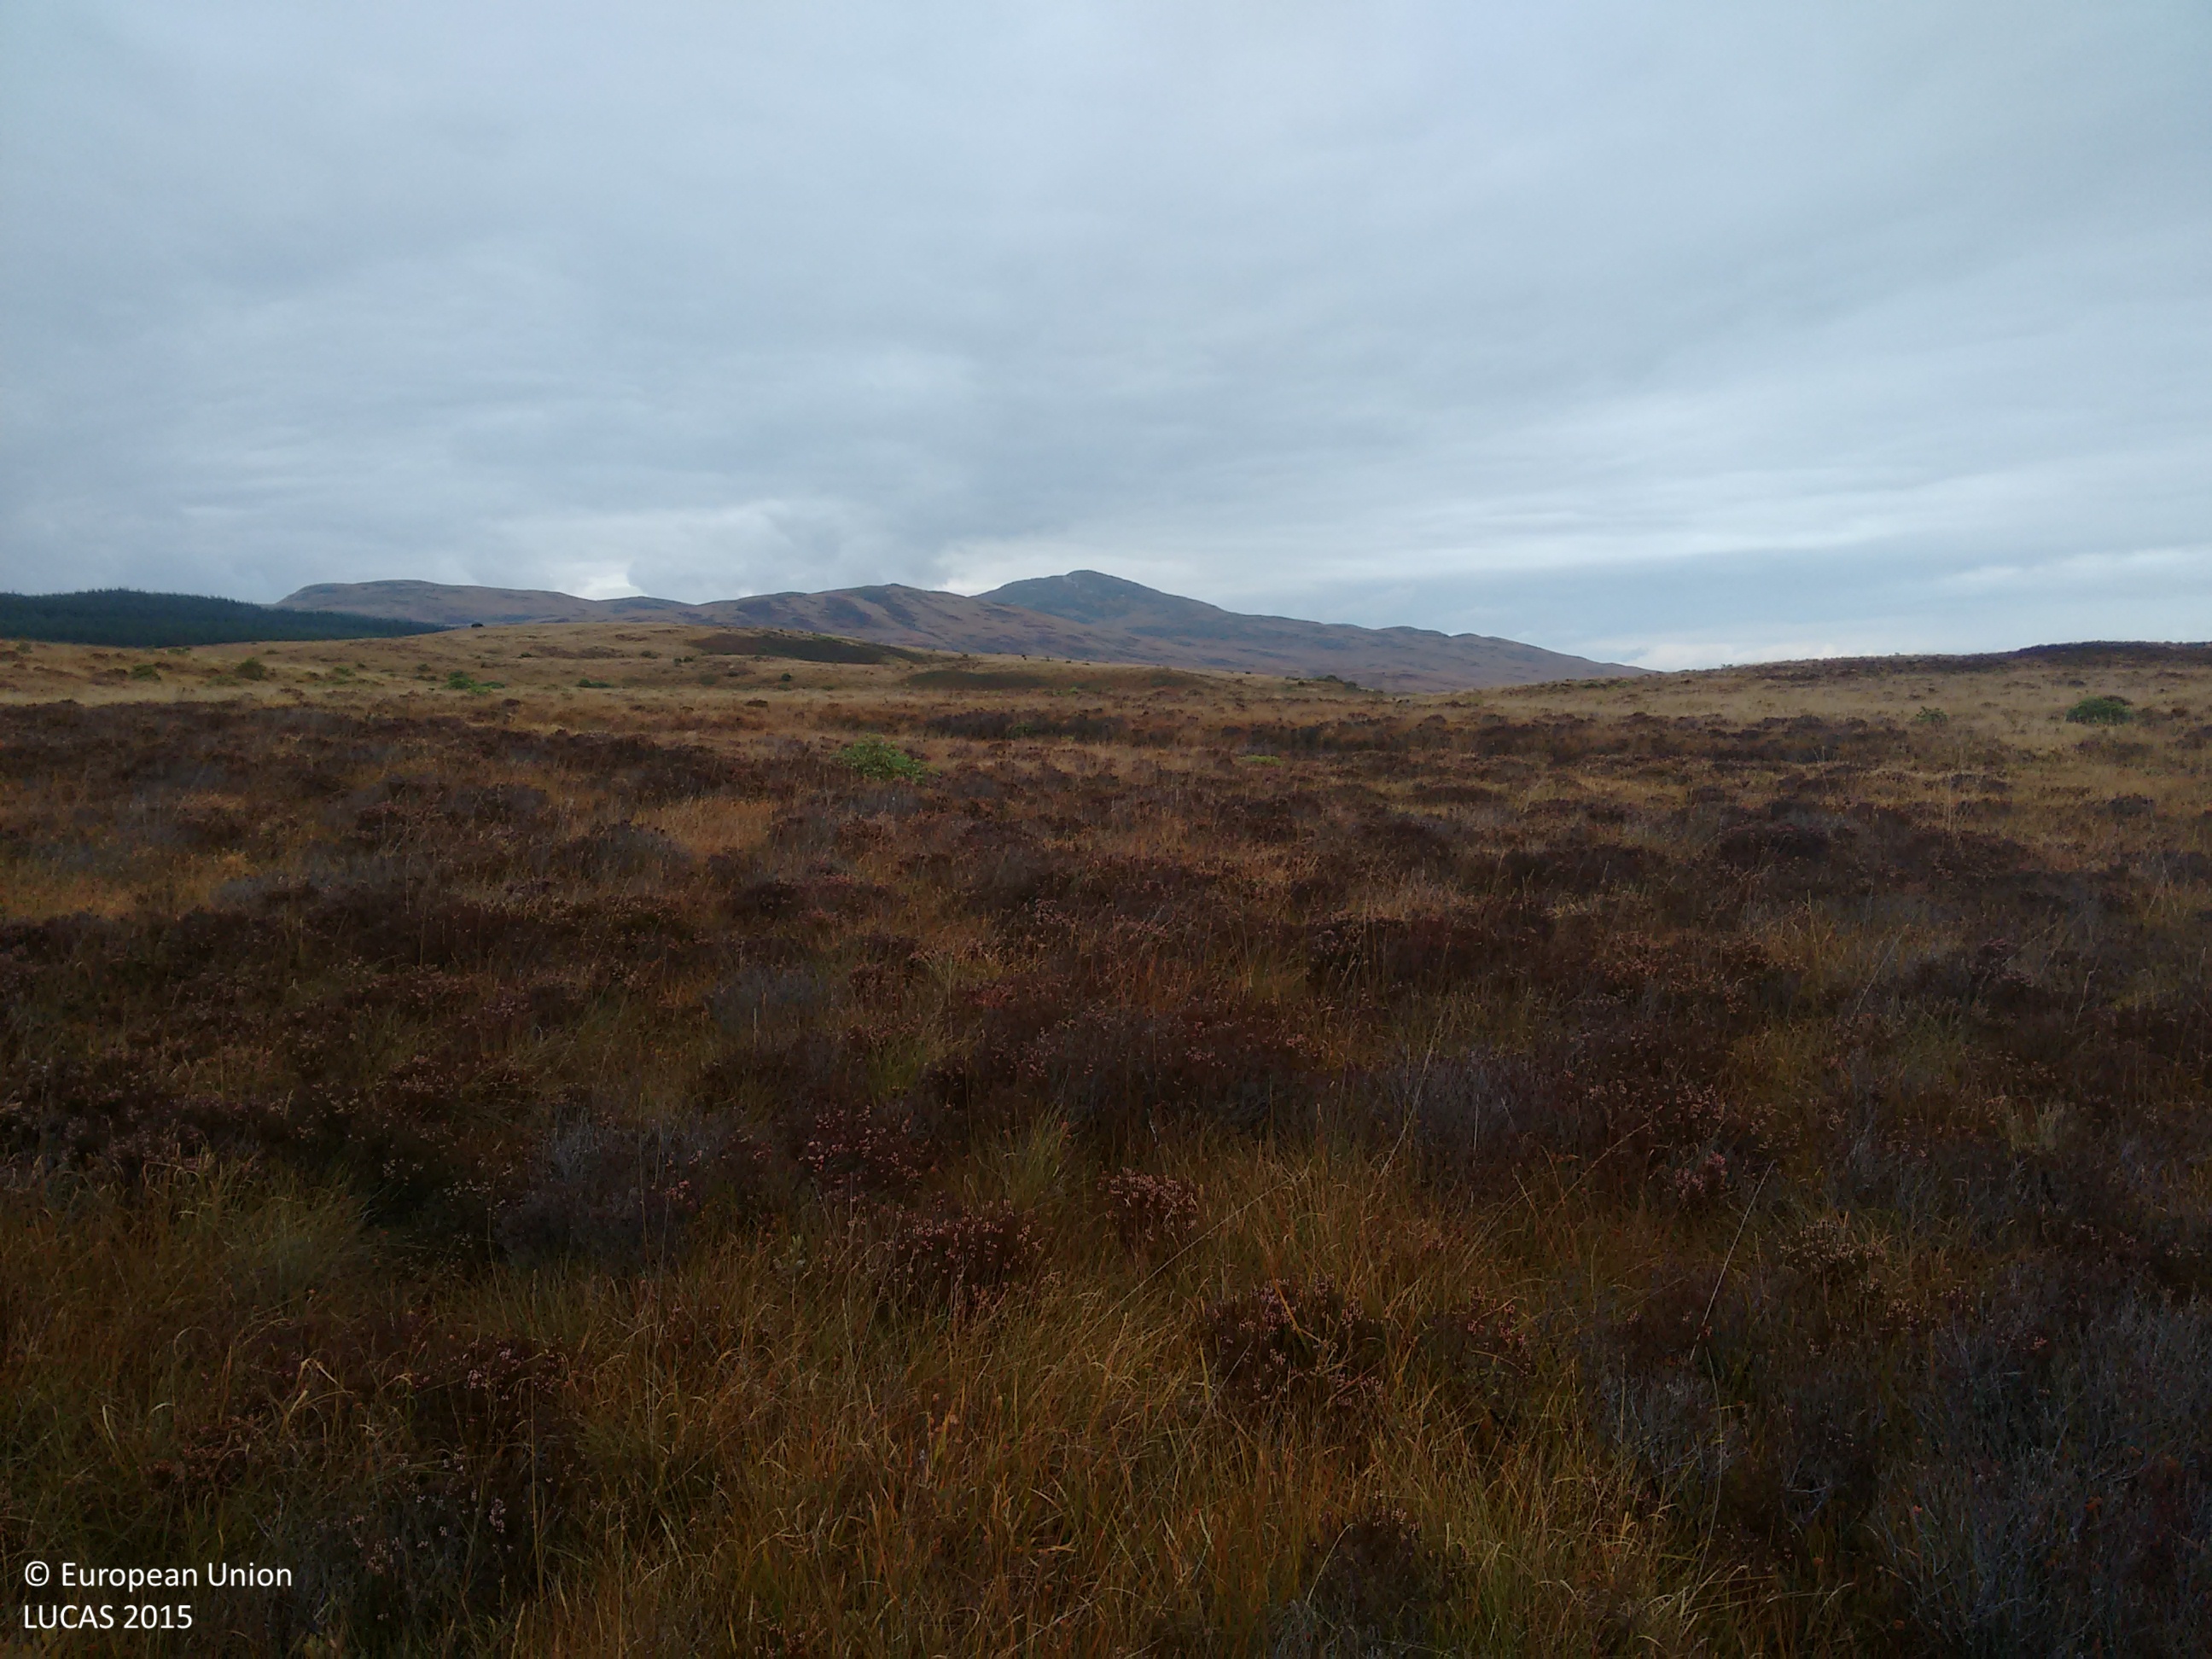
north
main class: Shrubland
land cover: Shrubland without tree cover
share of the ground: > 75 %
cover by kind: shrubs 80 %, herbaceous plants 10 %, lichens and mosses 10 %
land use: Agriculture (excluding fallow land and kitchen gardens)
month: October
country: GB
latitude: 55.8729
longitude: -6.1385
